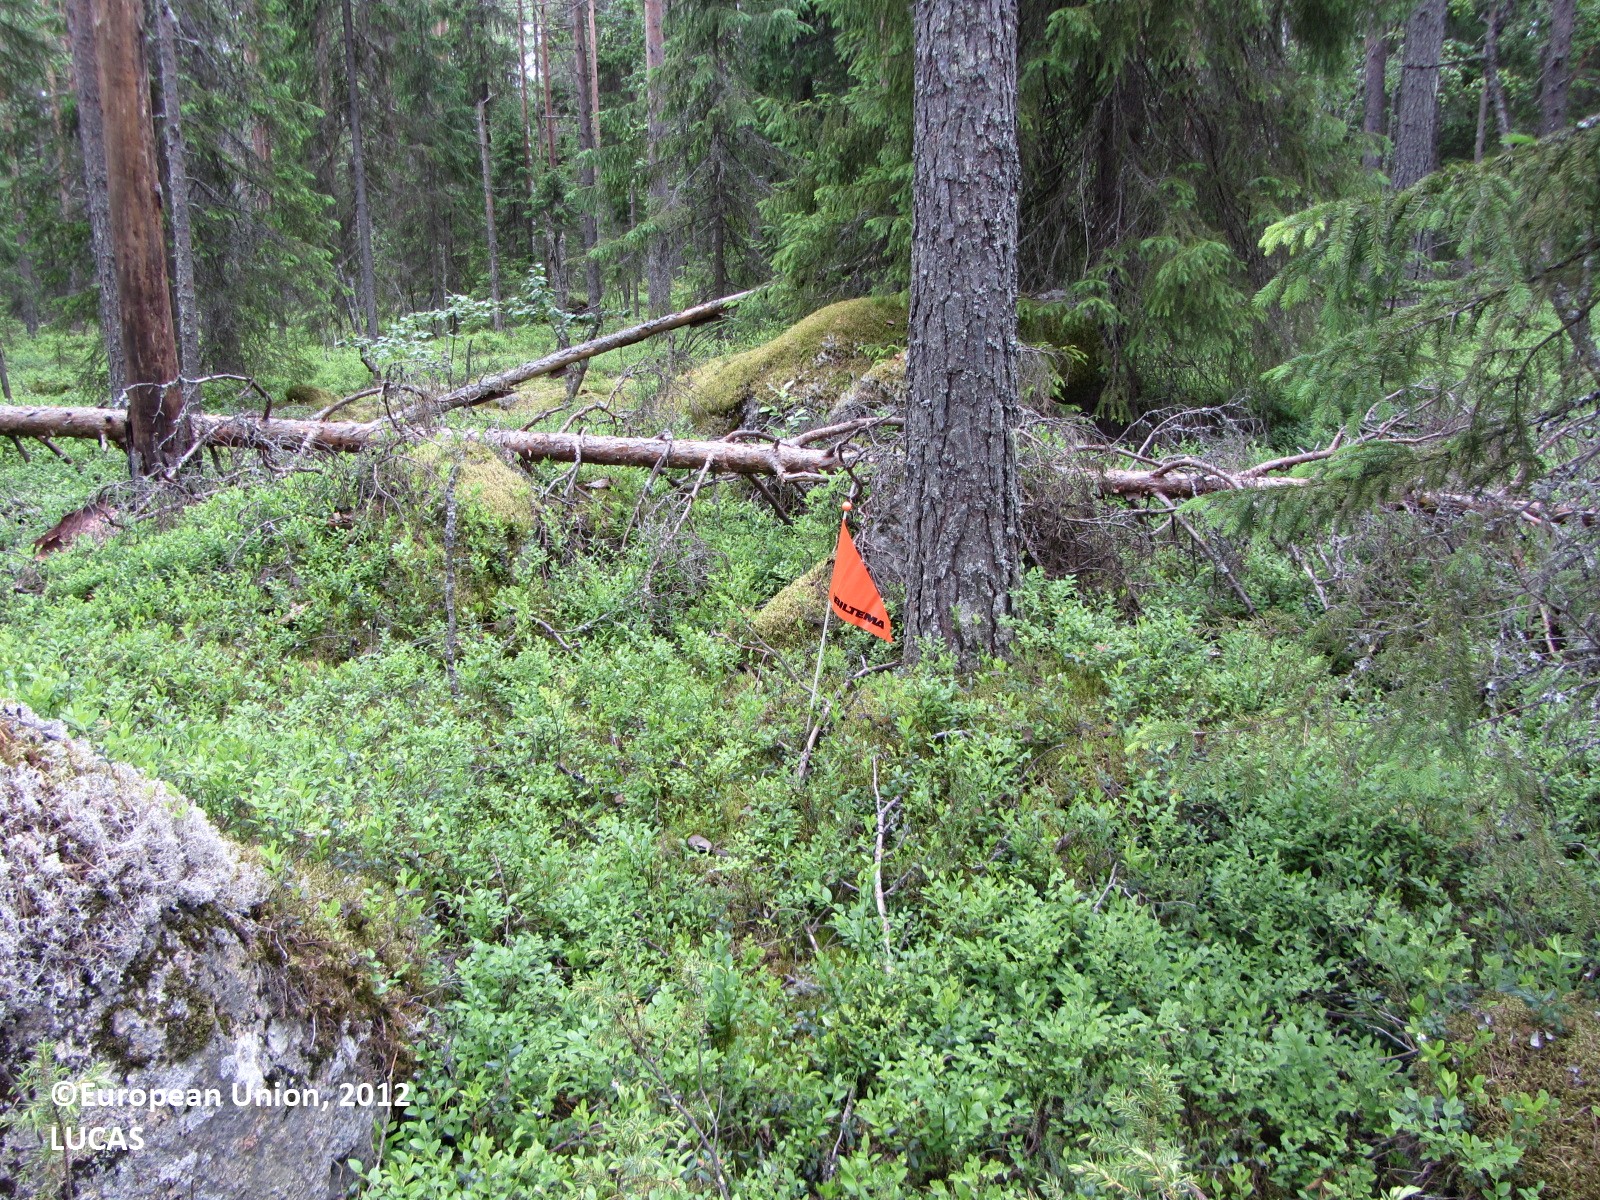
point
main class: Woodland
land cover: Pine dominated coniferous woodland
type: boreal forest
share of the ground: 50 - 75 %
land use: Forestry
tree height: > 5 m
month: June
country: FI
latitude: 62.7516
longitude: 25.5974
